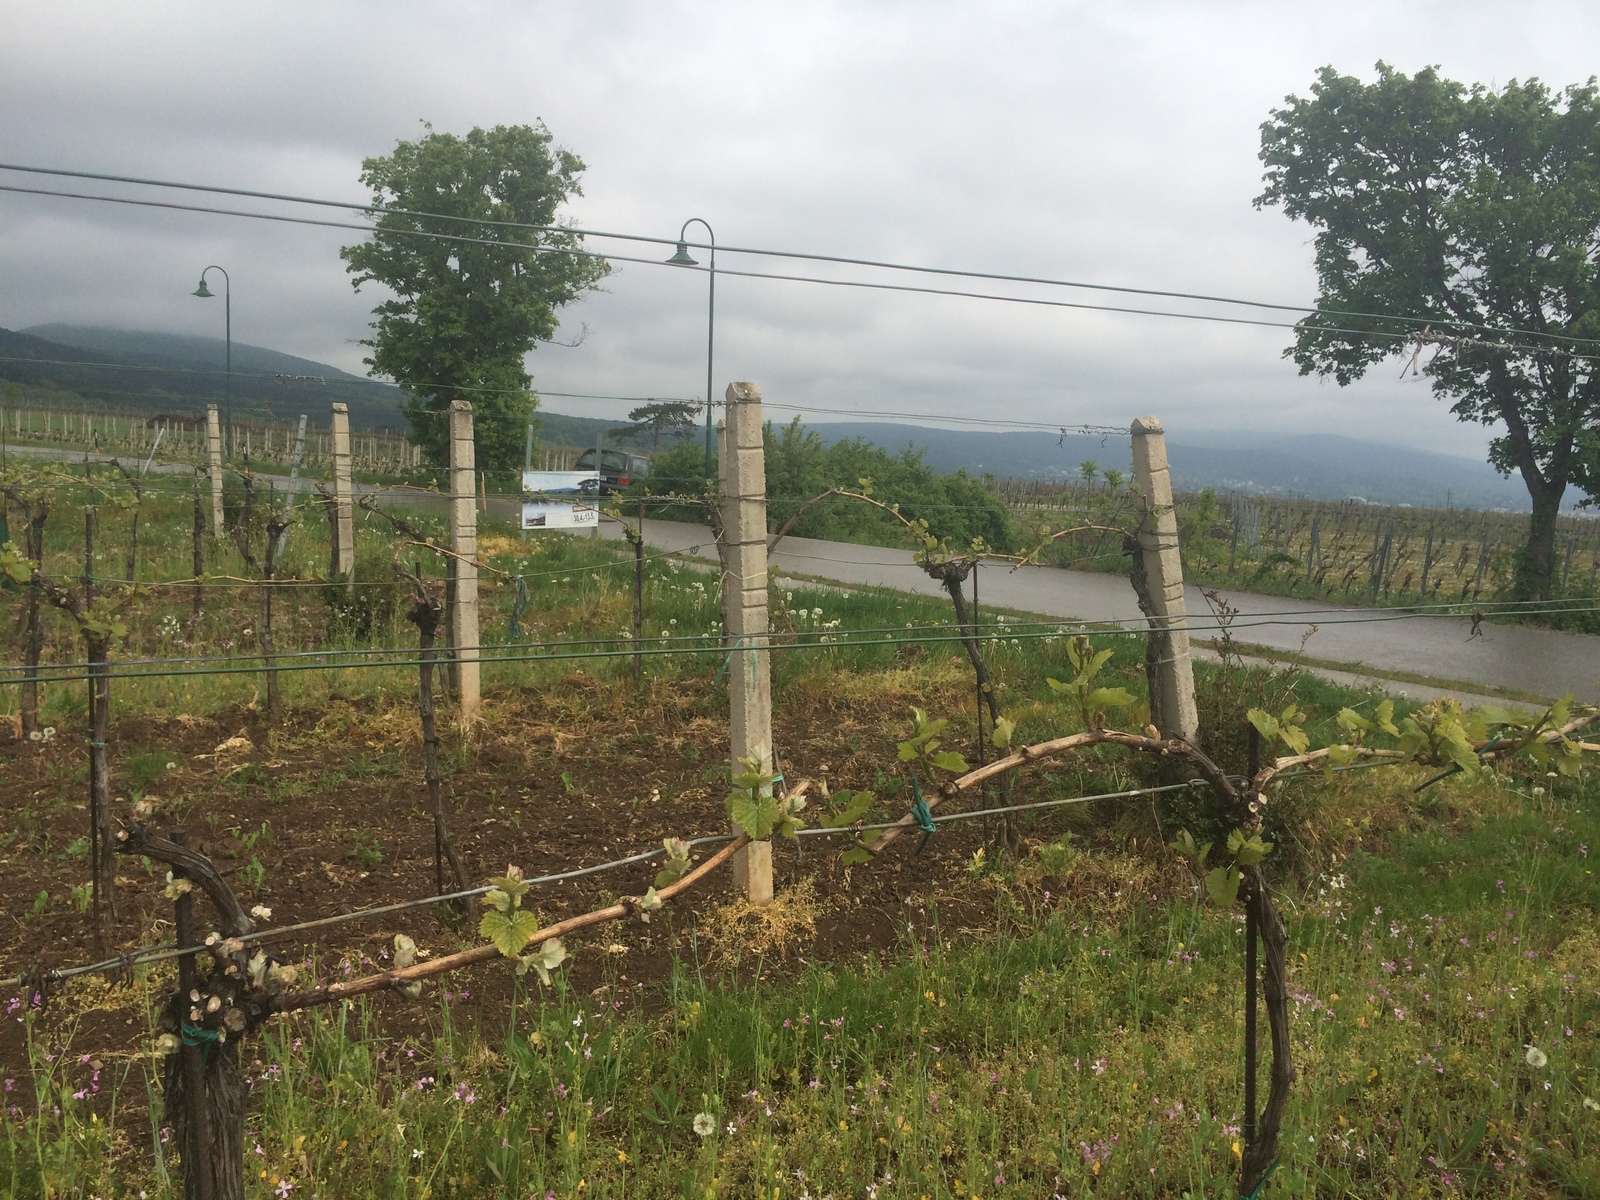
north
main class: Cropland
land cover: Vineyards
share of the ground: > 75 %
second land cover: Grassland without tree/shrub cover
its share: > 75 %
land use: Agriculture (excluding fallow land and kitchen gardens)
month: May
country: AT
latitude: 47.9765
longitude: 16.2065
